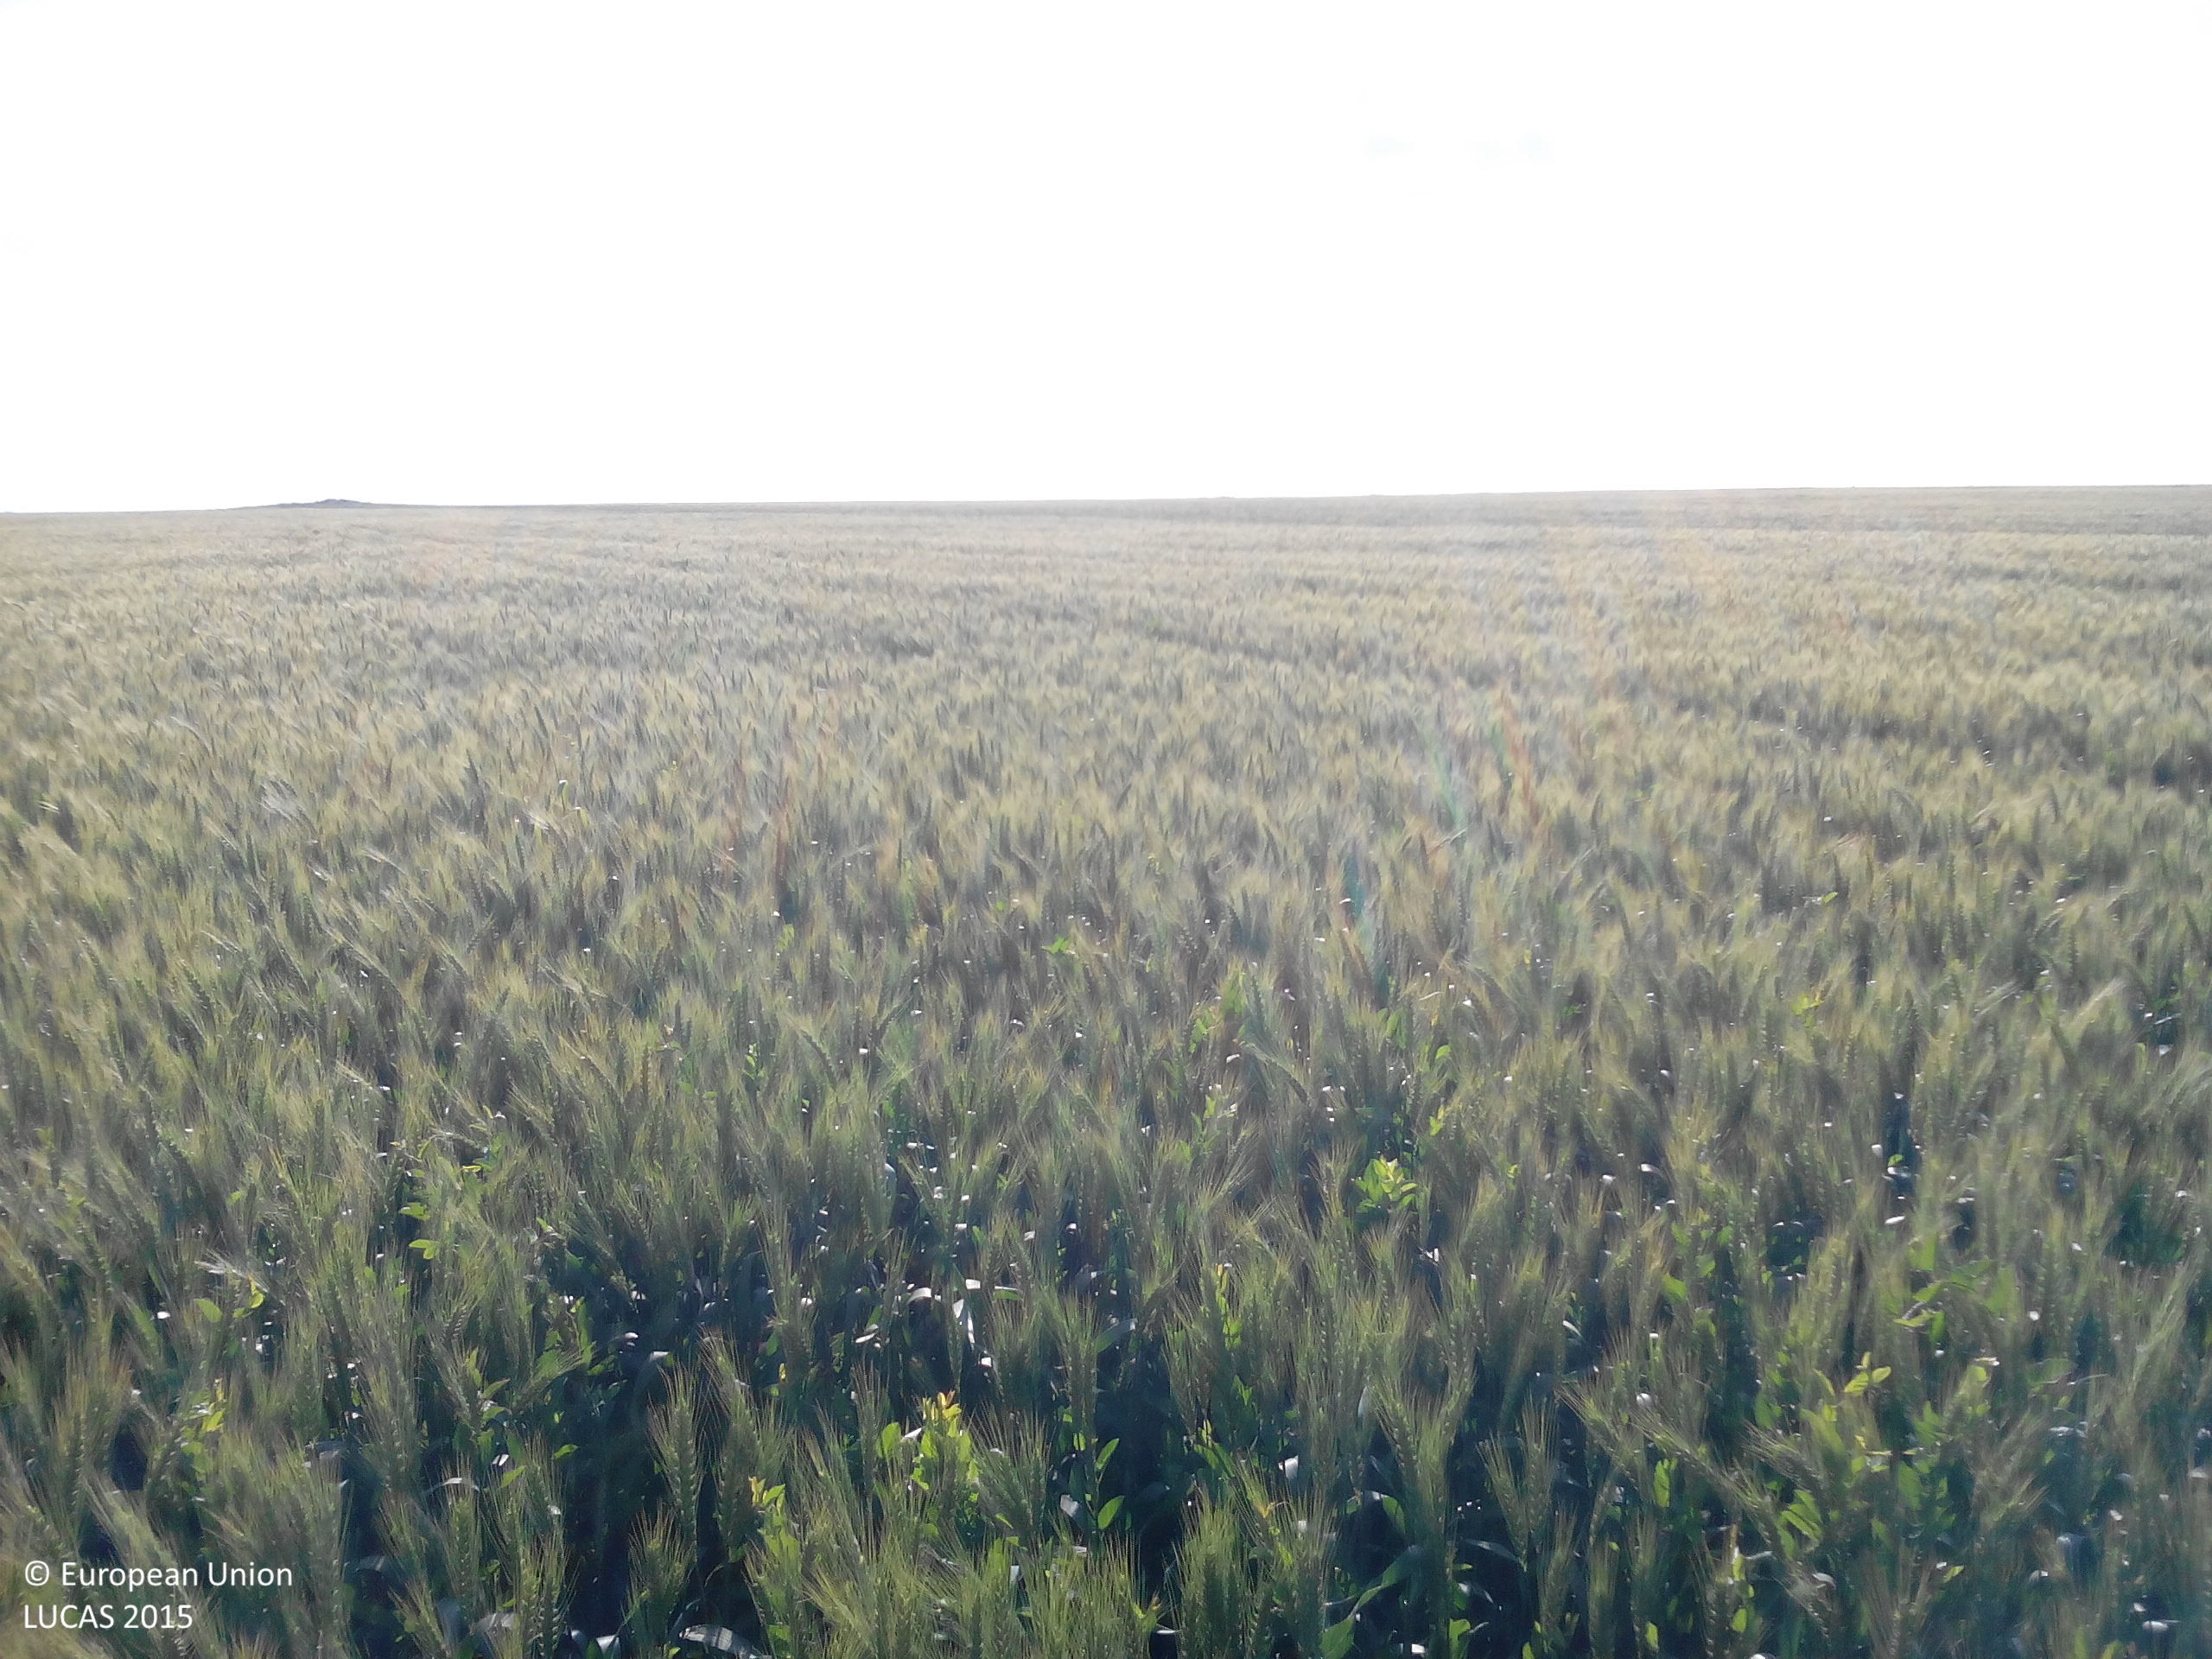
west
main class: Cropland
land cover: Common wheat
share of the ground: > 75 %
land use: Agriculture (excluding fallow land and kitchen gardens)
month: May
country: BG
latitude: 43.4704
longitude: 23.8578
